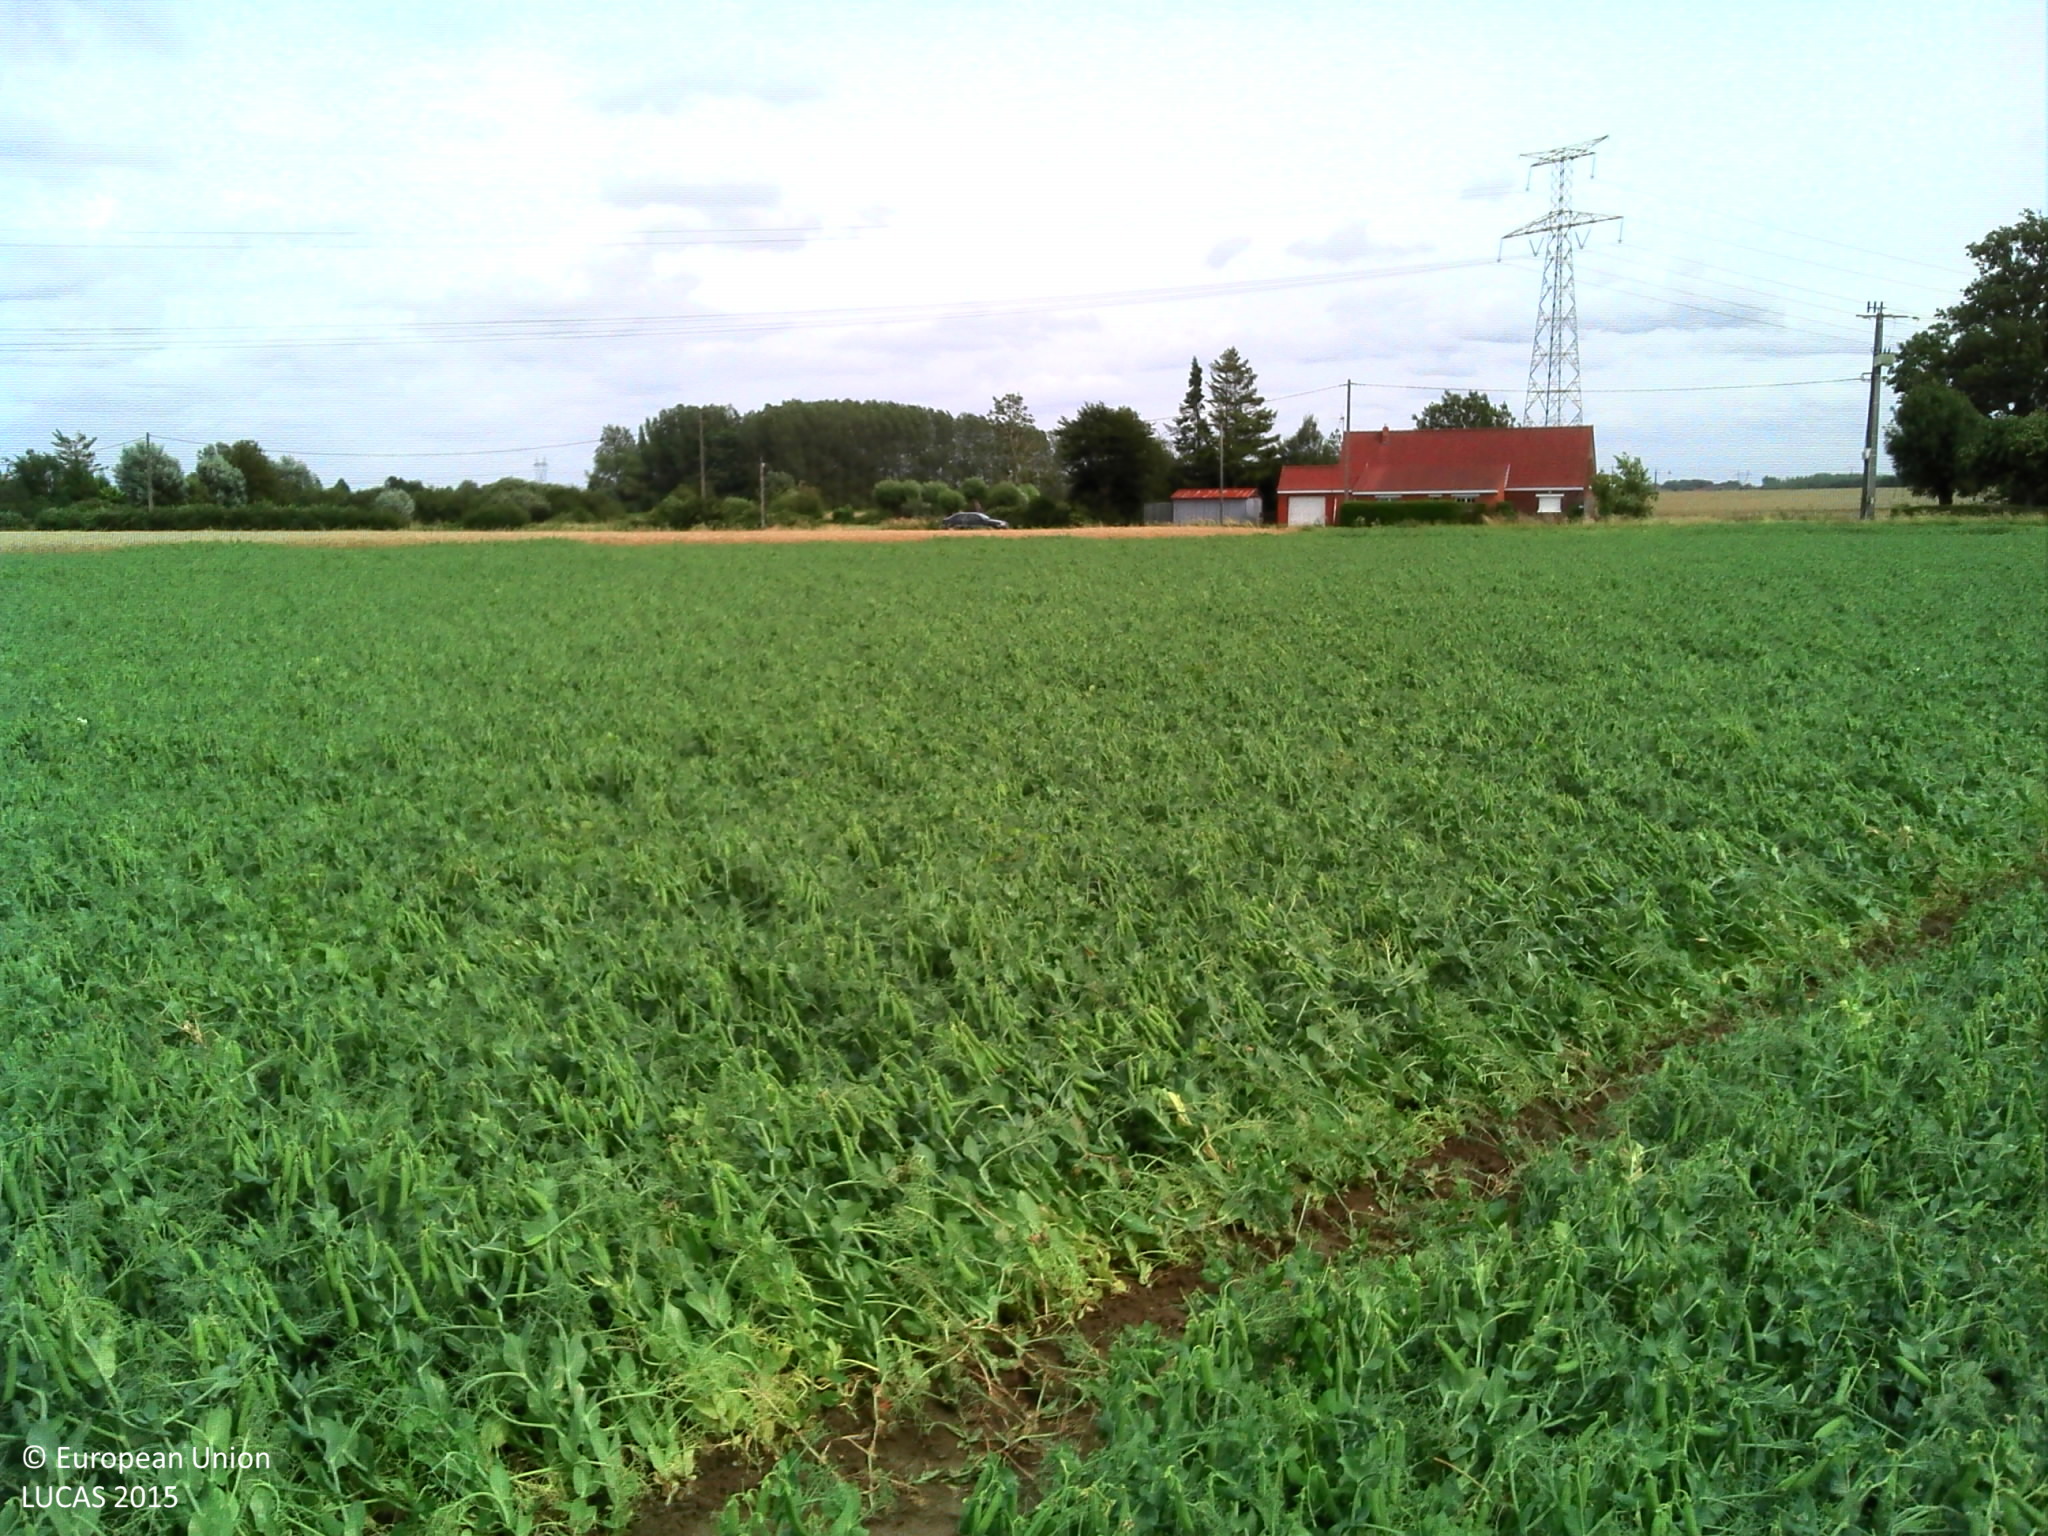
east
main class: Cropland
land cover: Dry pulses
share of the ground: > 75 %
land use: Agriculture (excluding fallow land and kitchen gardens)
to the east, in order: Dry pulses; Durum wheat; Electric lines; Grass margins; Ditches and canals; Grass margins; Paved roads, cycling and walking lanes; Grass margins; Electric lines; Grassland without tree/shrub cover; Abandoned hedges; Durum wheat
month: July
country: FR
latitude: 50.7078
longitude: 2.4108
